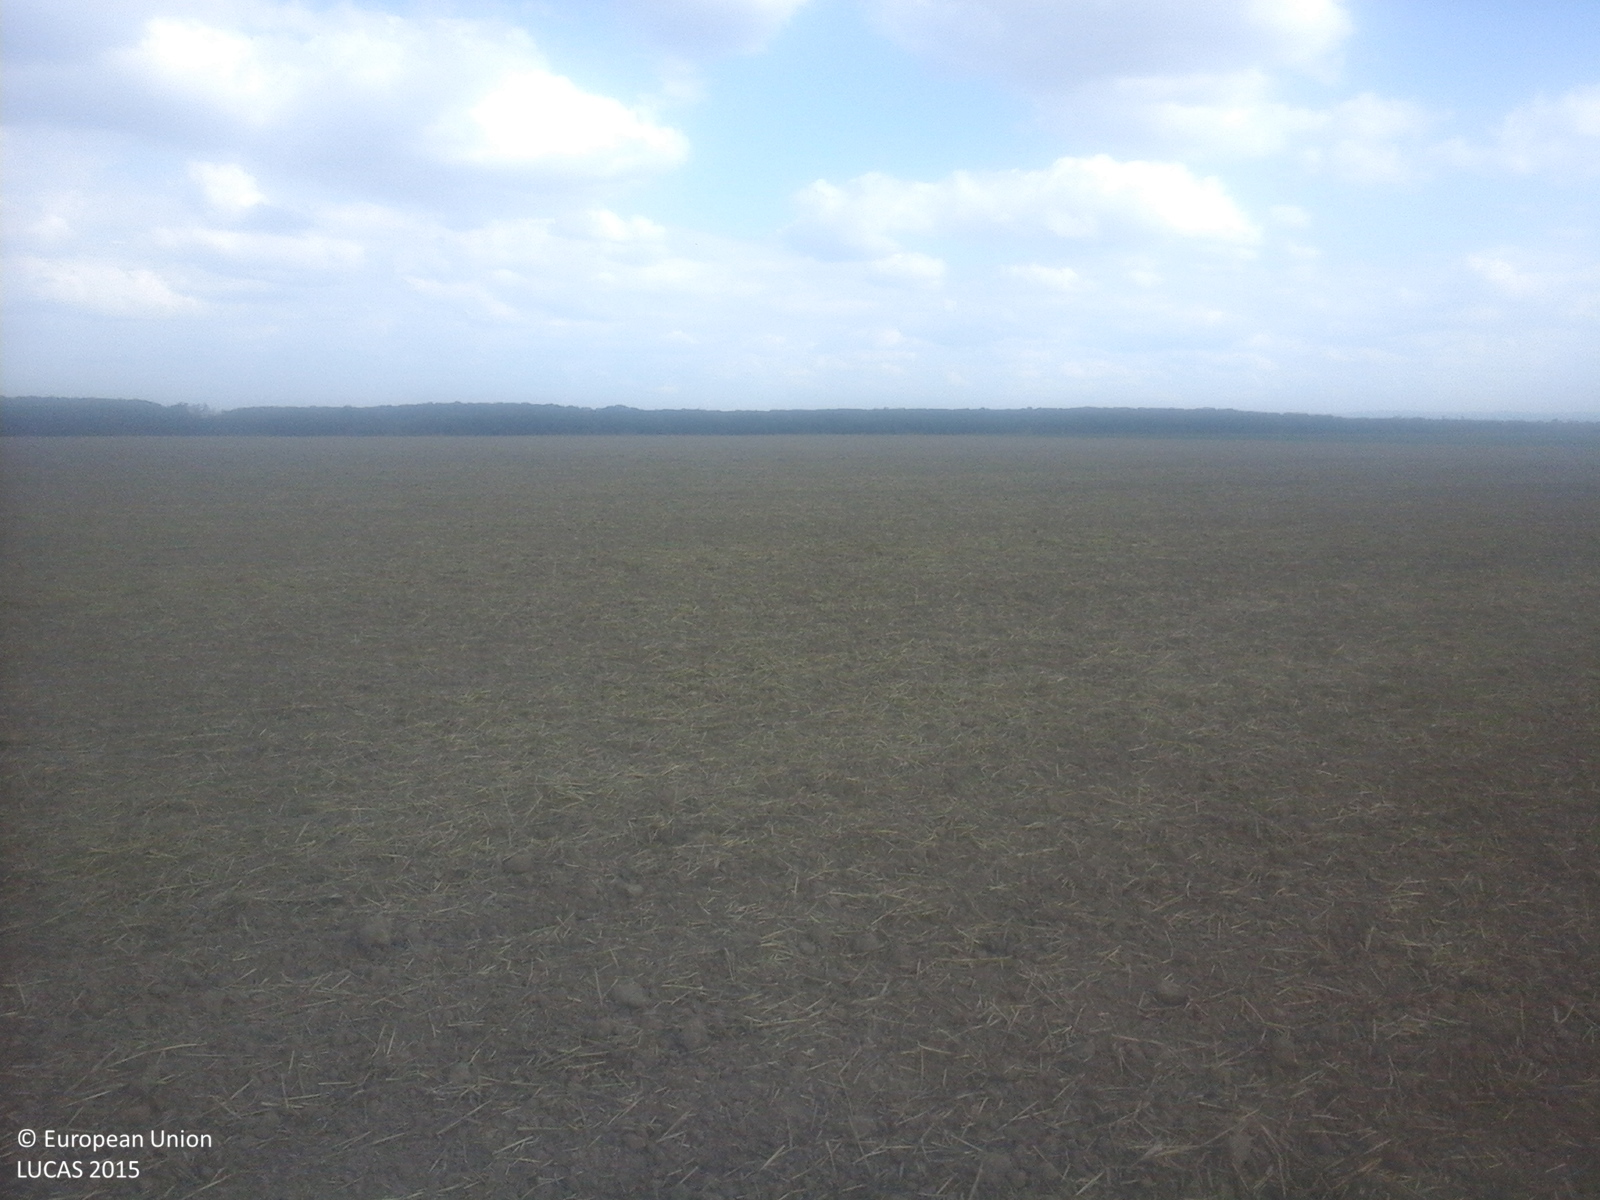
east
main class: Cropland
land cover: Common wheat
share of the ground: < 10 %
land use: Agriculture (excluding fallow land and kitchen gardens)
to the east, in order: Common wheat; Shrubland with sparse tree cover
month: September
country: RO
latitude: 47.6885
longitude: 22.6775
